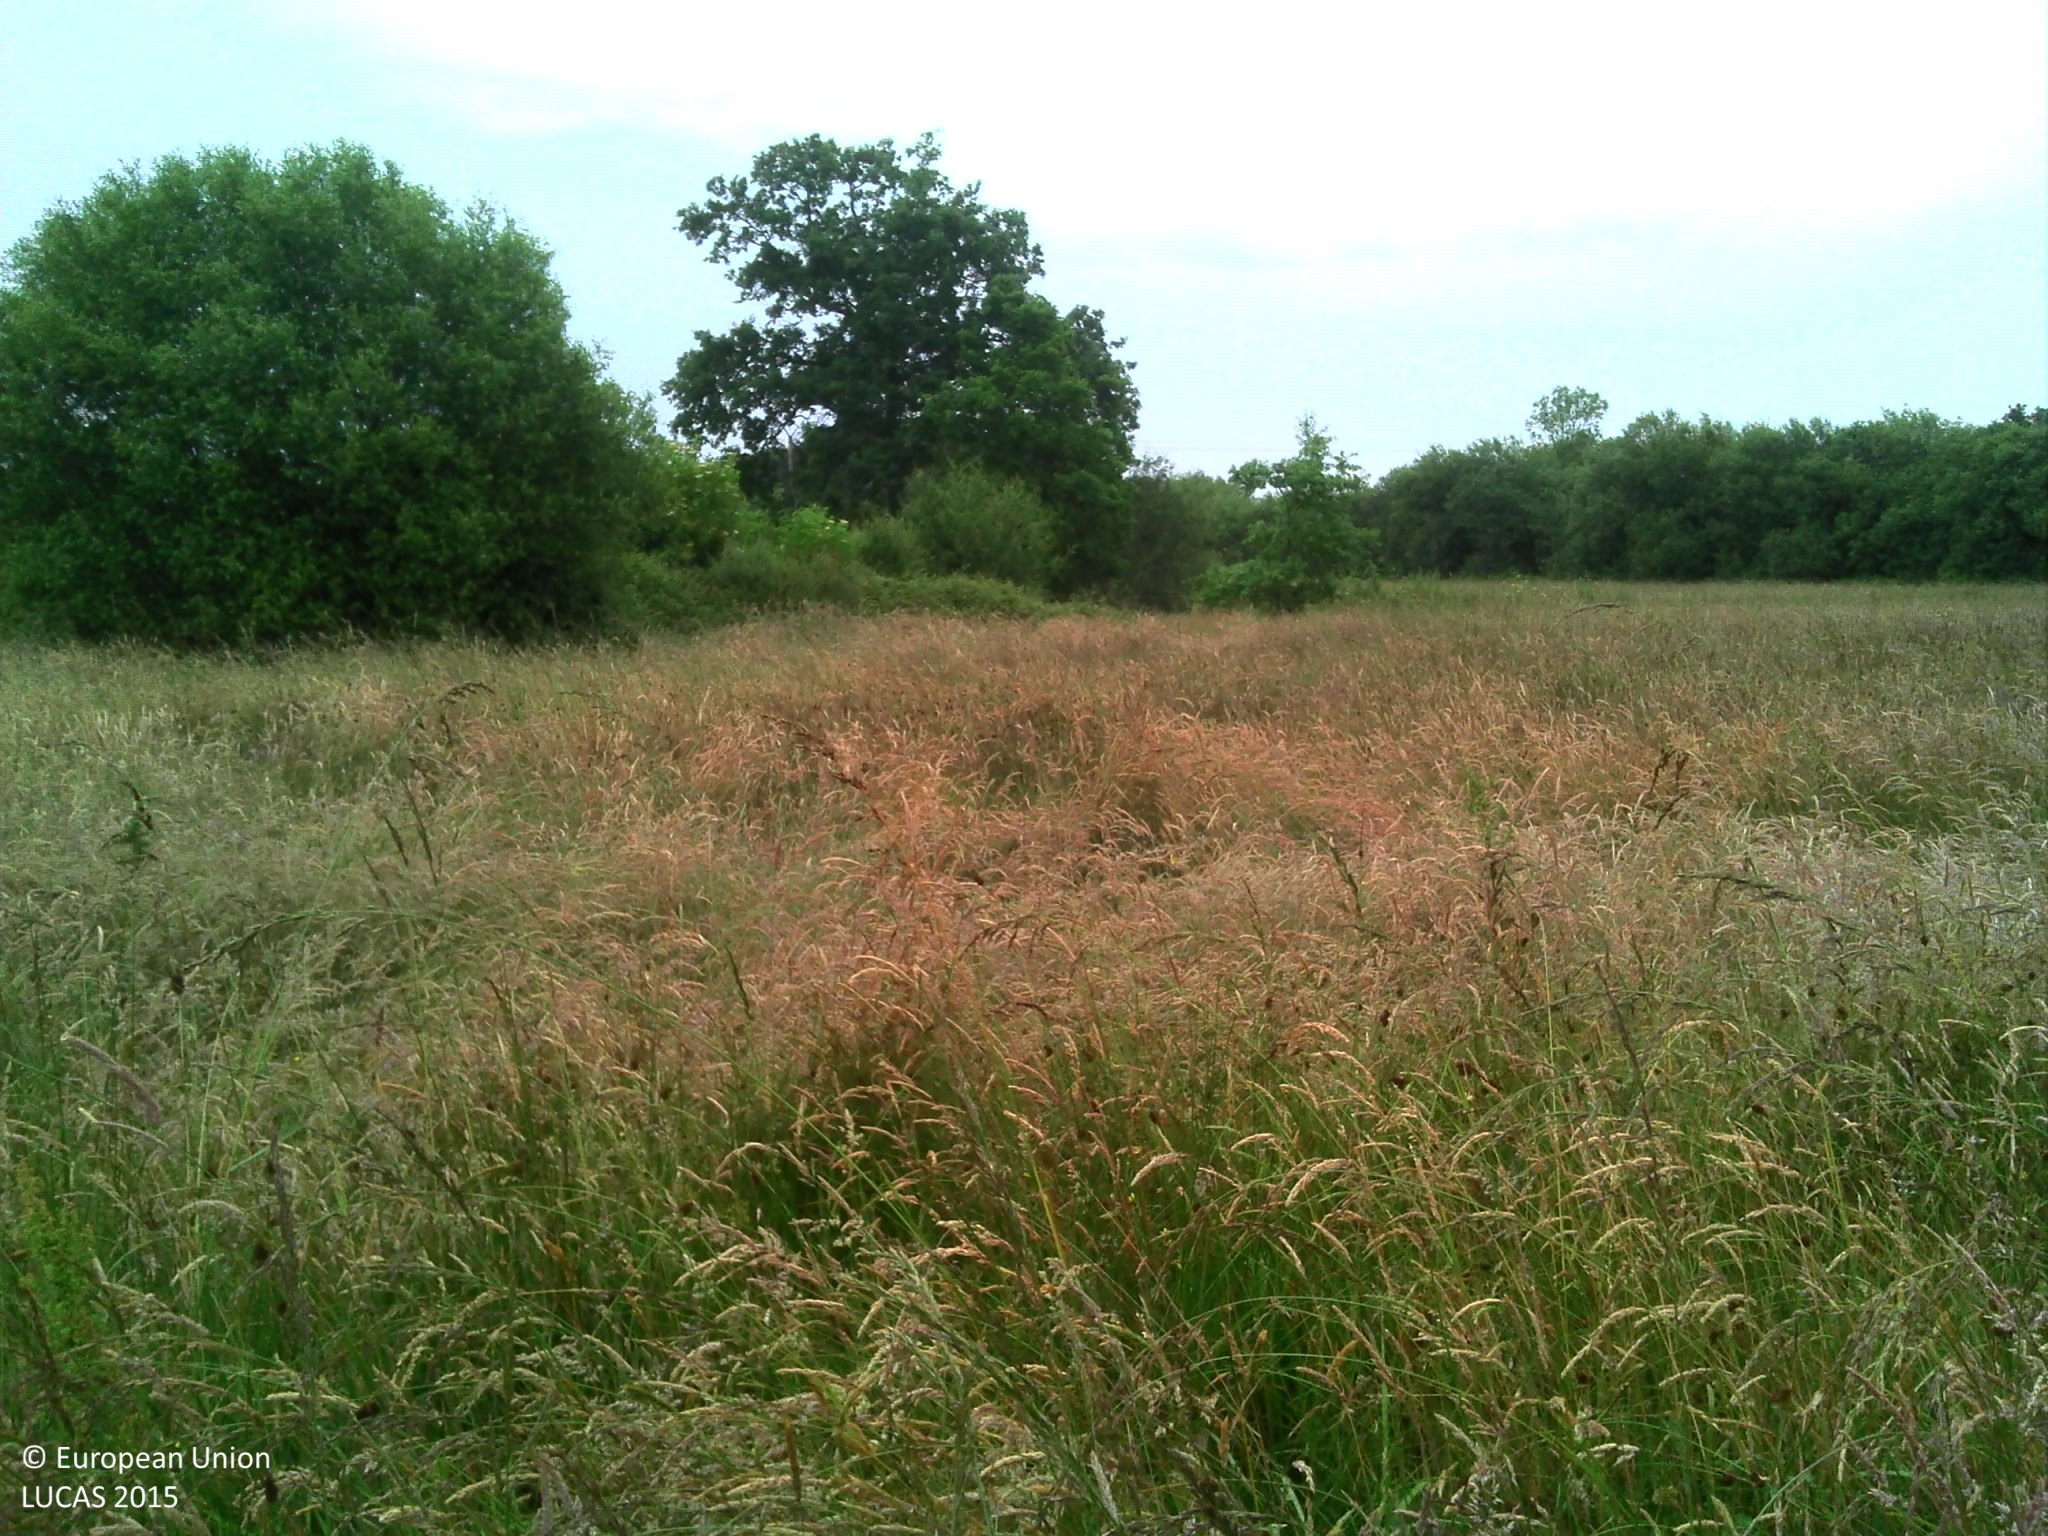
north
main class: Grassland
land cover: Grassland without tree/shrub cover
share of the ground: > 75 %
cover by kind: herbaceous plants 100 %
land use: Agriculture (excluding fallow land and kitchen gardens)
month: June
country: FR
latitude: 46.8581
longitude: -1.6497
